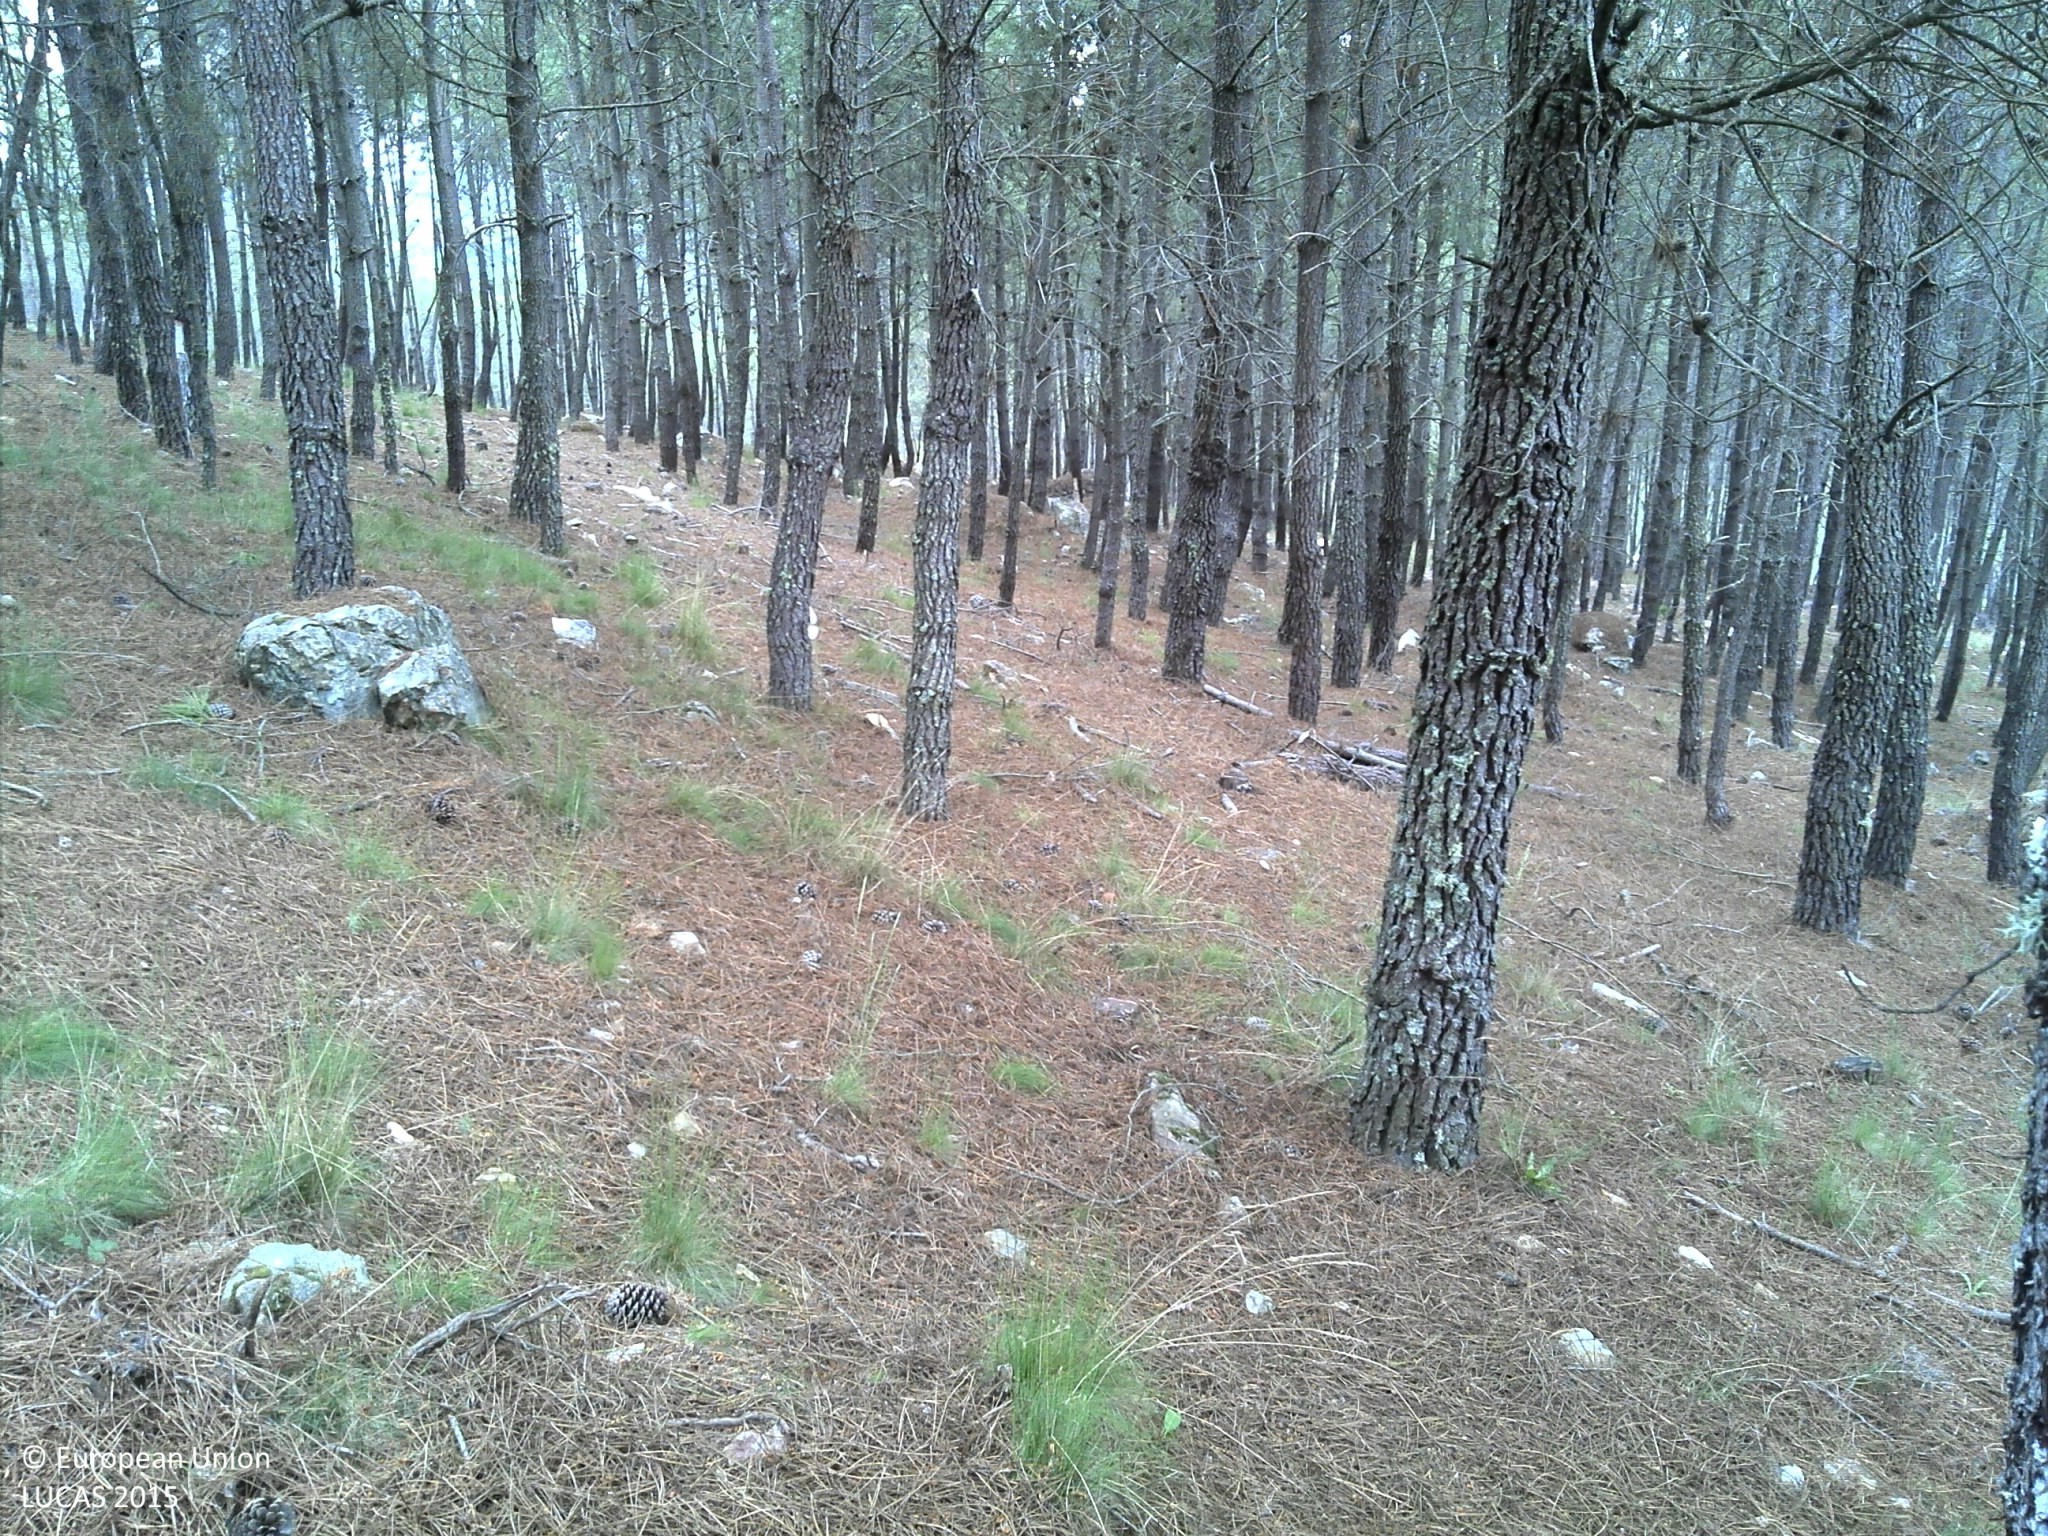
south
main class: Woodland
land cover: Pine dominated coniferous woodland
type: coniferous forest of the mediterranean region
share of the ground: 50 - 75 %
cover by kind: coniferous forest trees 75 %, unconsolidated bare surface 25 %
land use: Forestry
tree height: > 5 m
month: May
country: PT
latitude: 41.7461
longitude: -7.0632
